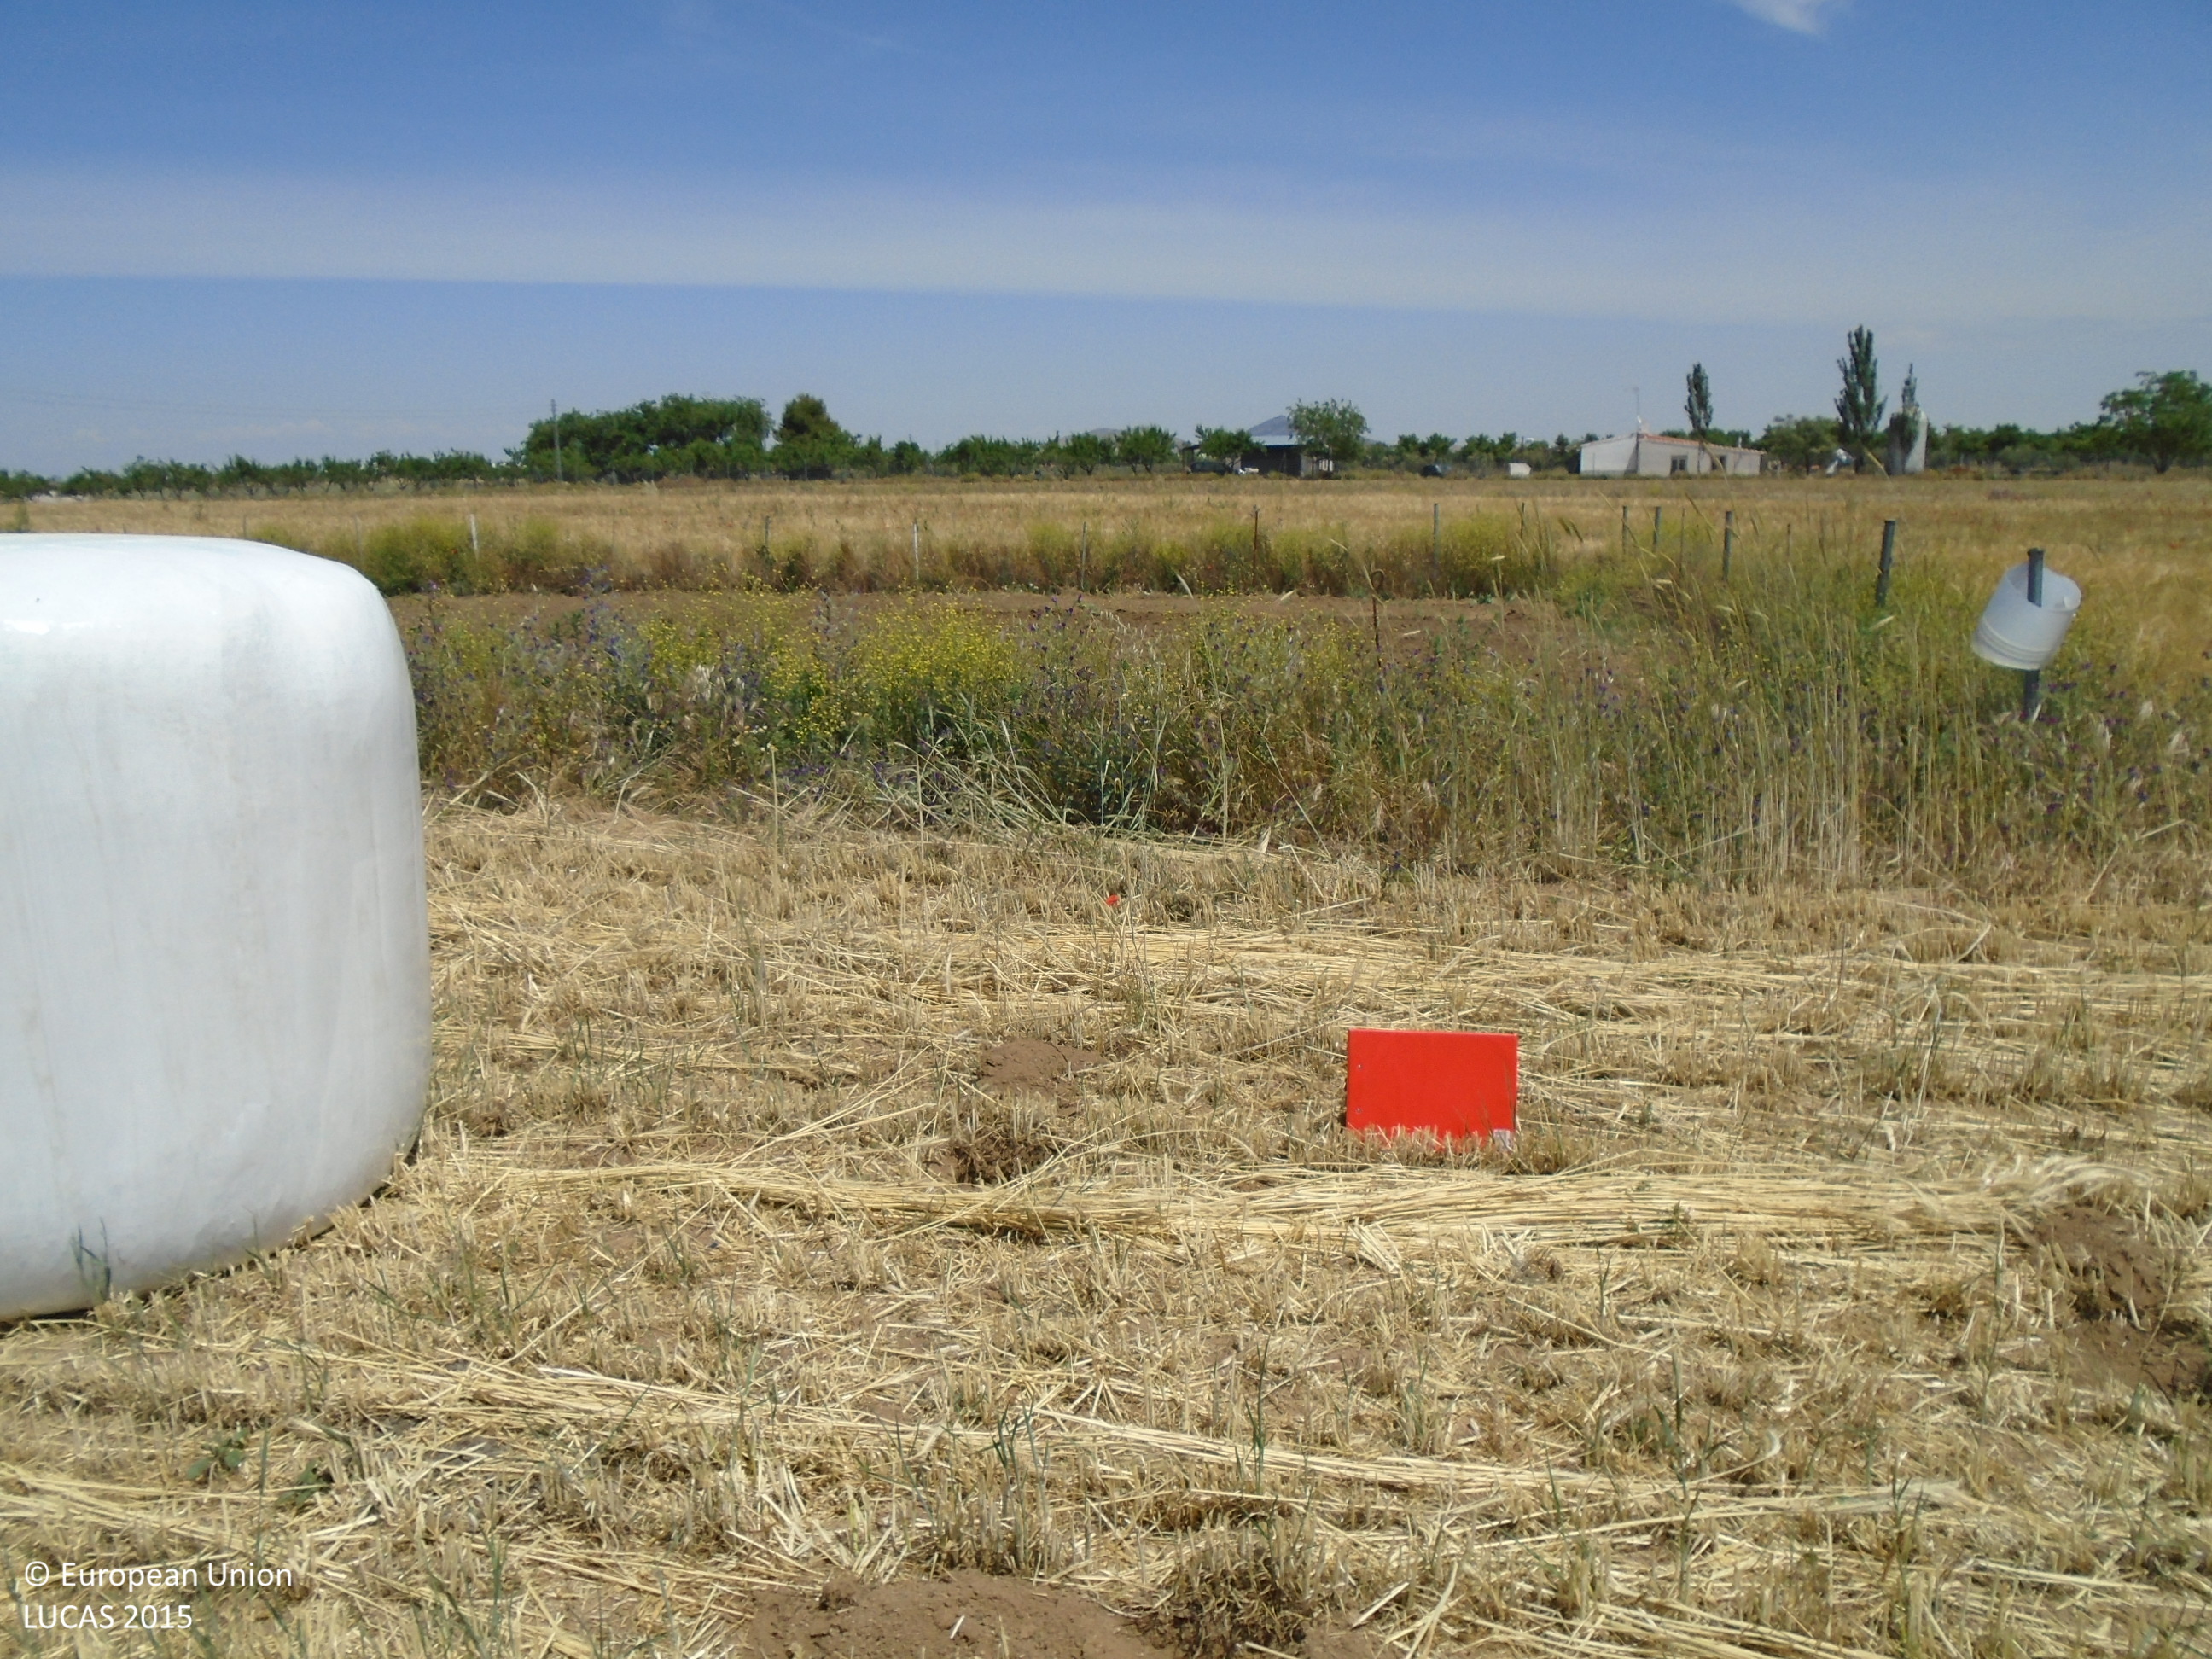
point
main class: Cropland
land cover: Rye
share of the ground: > 75 %
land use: Agriculture (excluding fallow land and kitchen gardens)
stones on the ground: < 10 %
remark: Harvested field
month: May
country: ES
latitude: 39.6447
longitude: -4.2394
